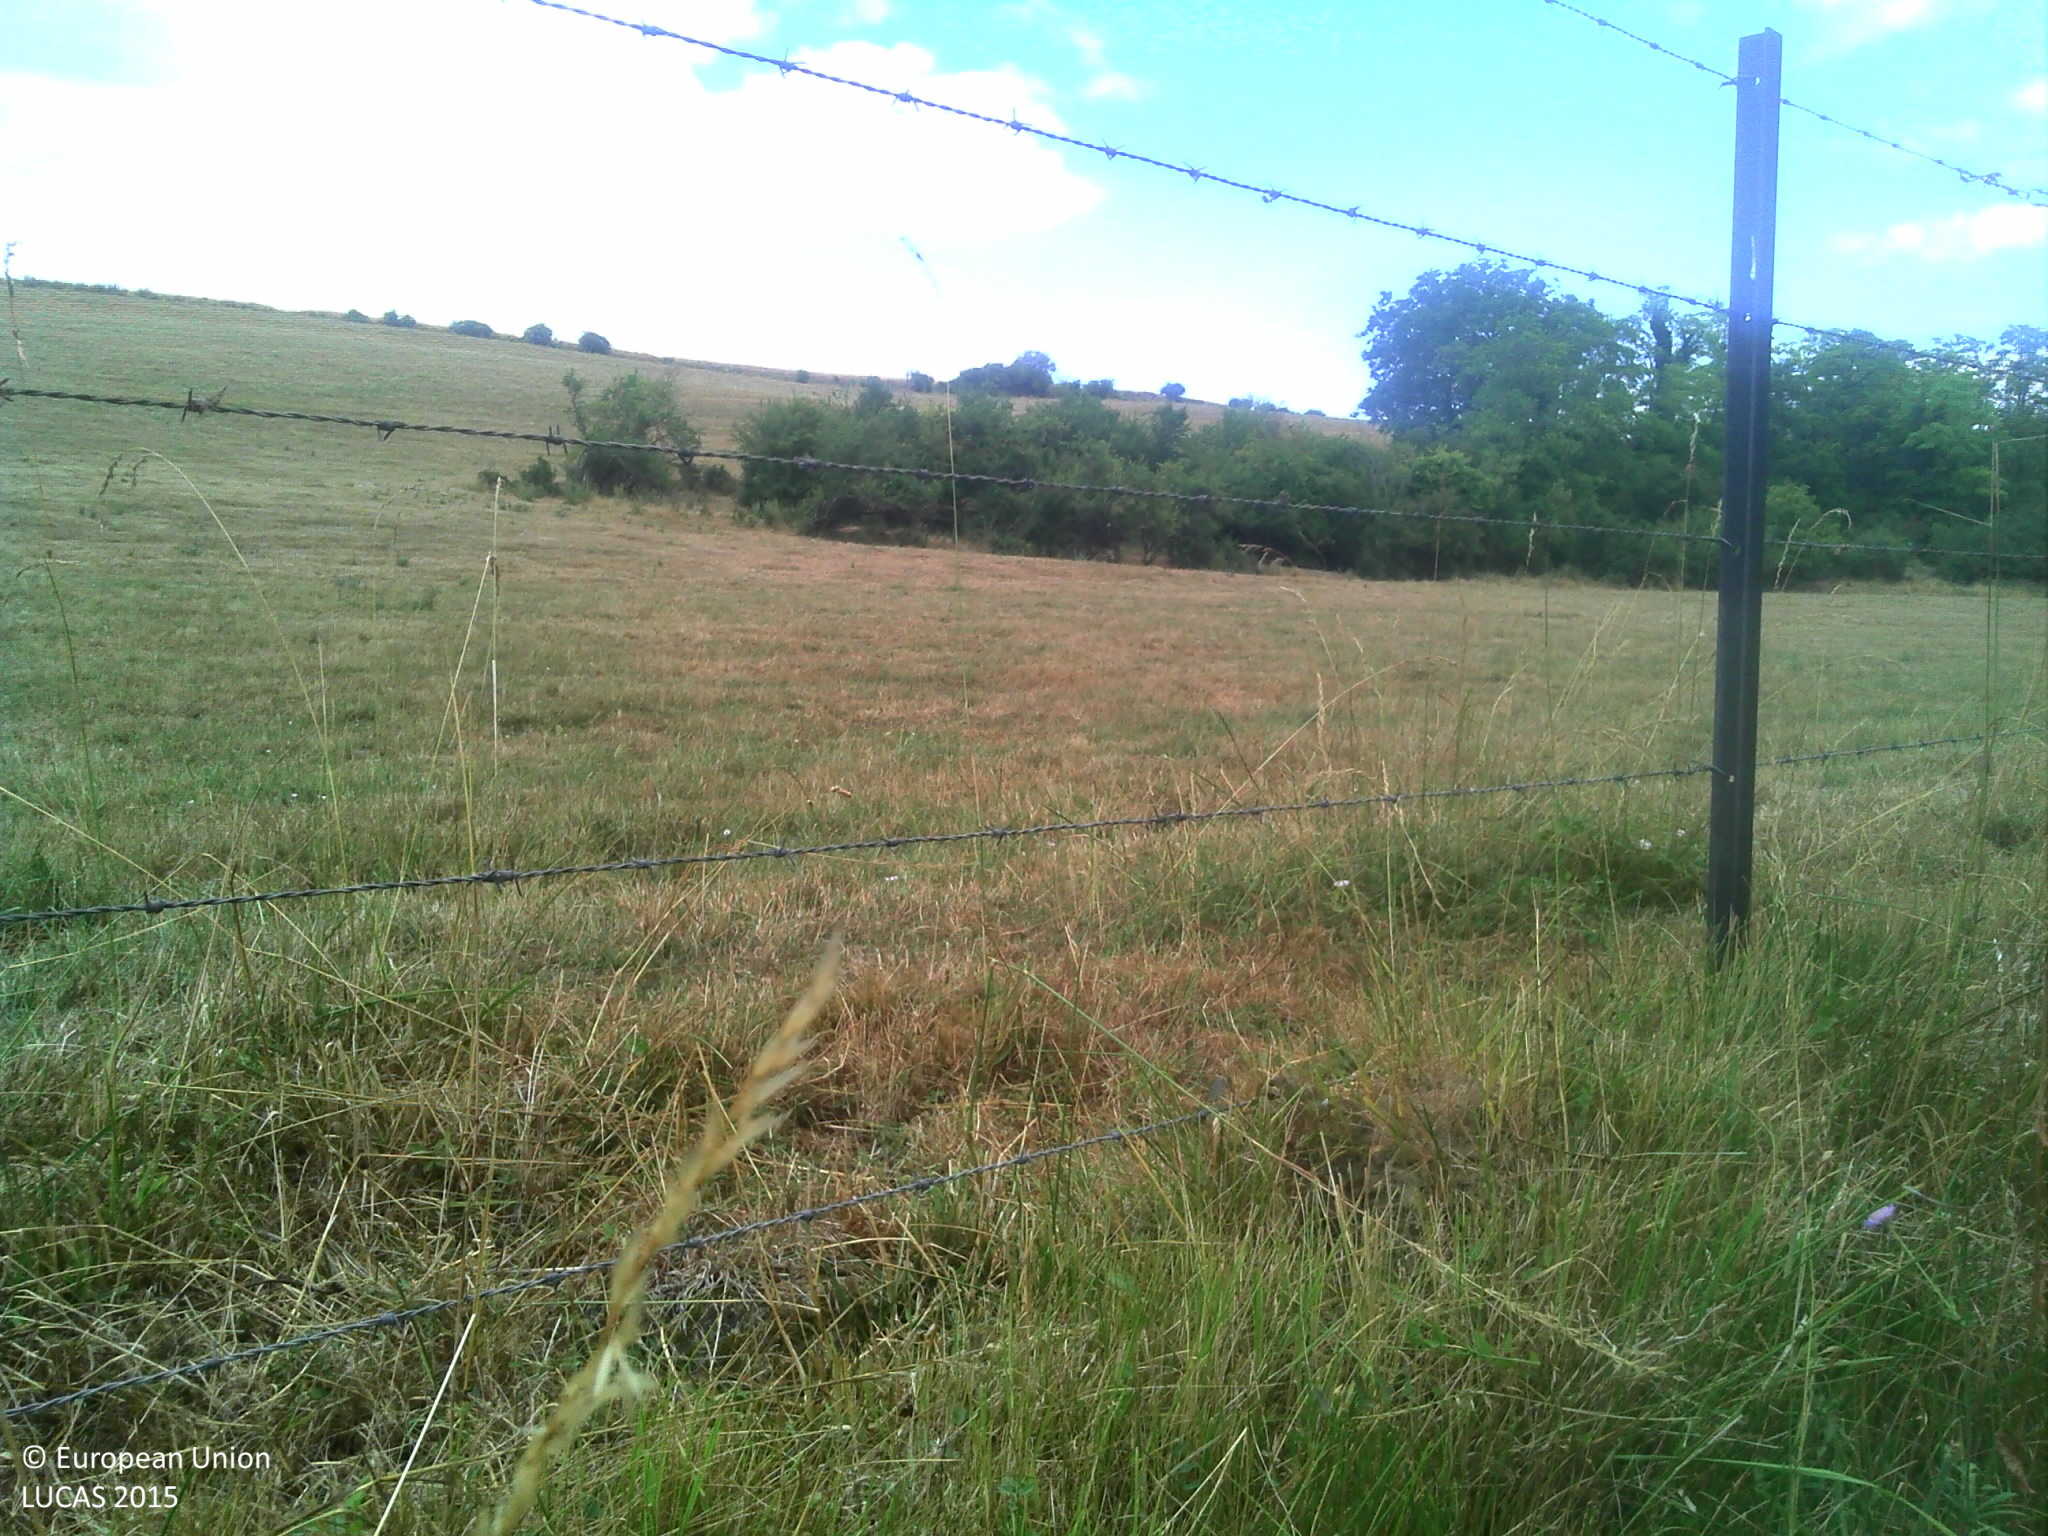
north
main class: Grassland
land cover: Grassland without tree/shrub cover
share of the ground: > 75 %
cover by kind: herbaceous plants 100 %
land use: Agriculture (excluding fallow land and kitchen gardens)
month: July
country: FR
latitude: 49.2680
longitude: 3.6581
